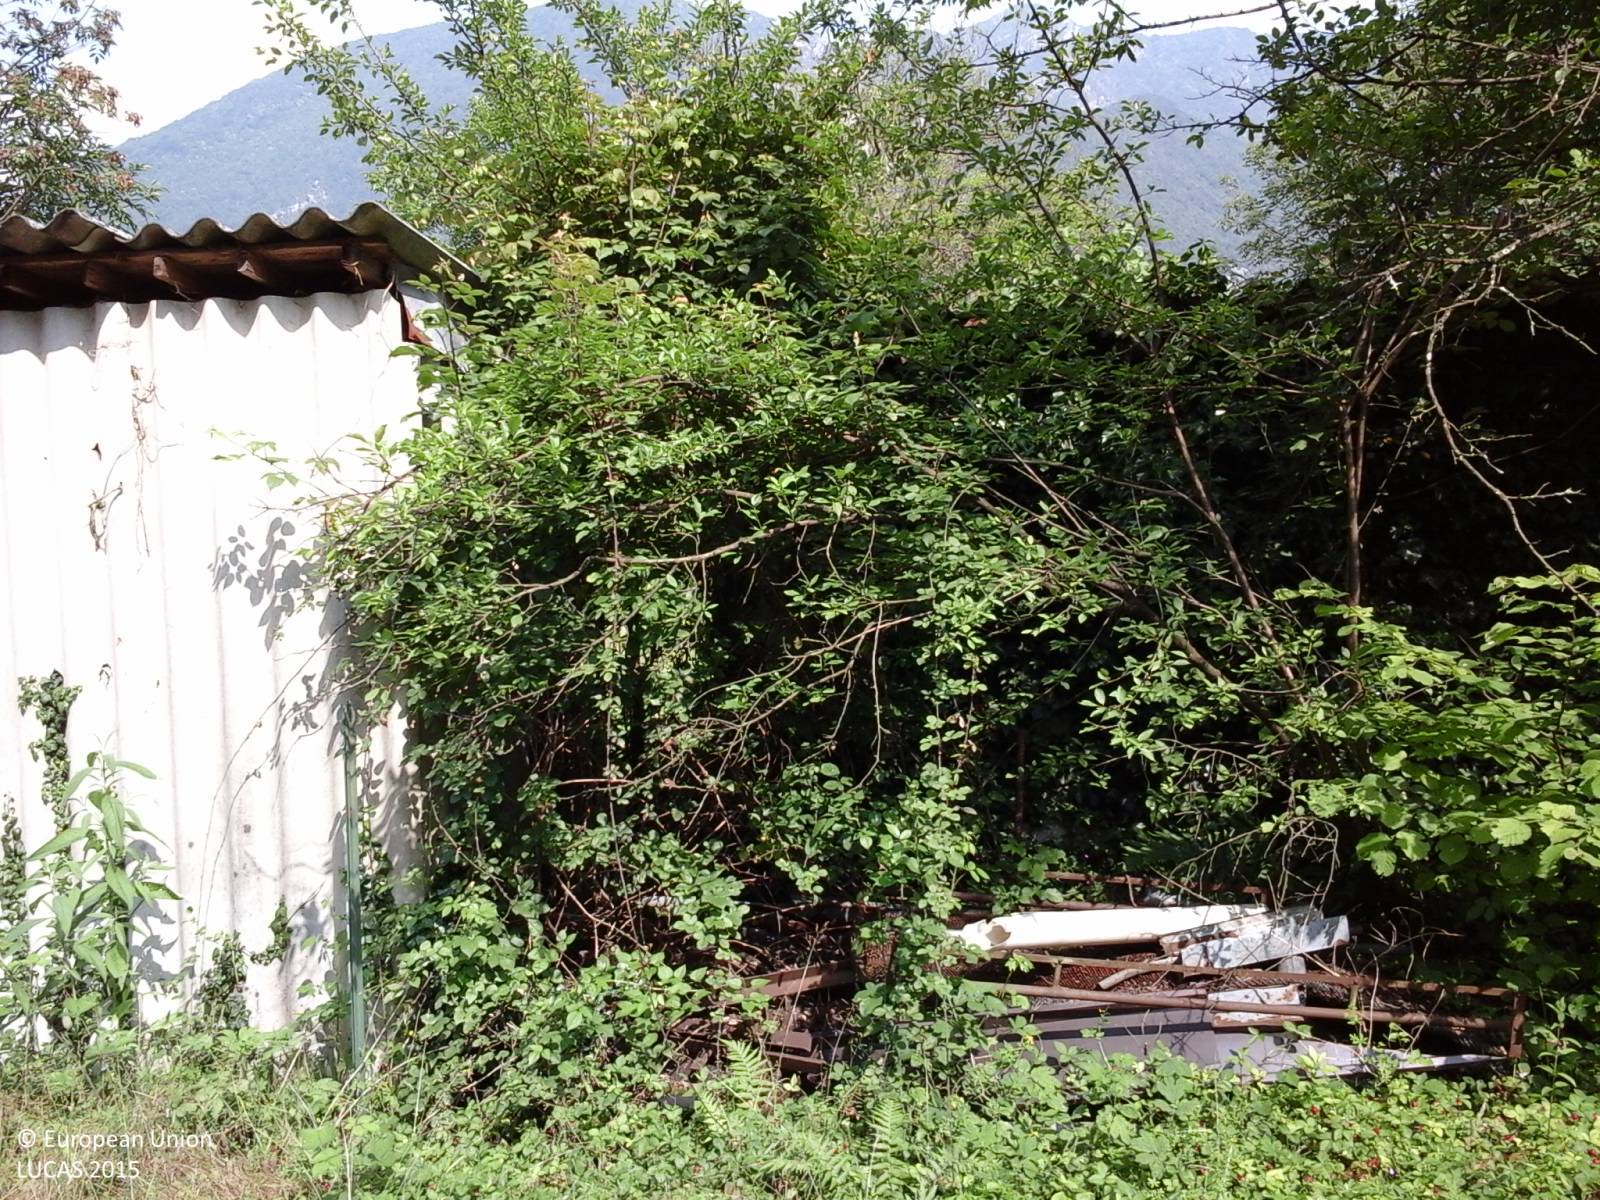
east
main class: Grassland
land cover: Grassland without tree/shrub cover
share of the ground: > 75 %
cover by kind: herbaceous plants 100 %
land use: Agriculture (excluding fallow land and kitchen gardens)
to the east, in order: Grassland without tree/shrub cover; Managed hedges; Artificial constructions in urban areas; Managed hedges; Grass margins; Potatoes; Grassland with sparse tree/shrub cover; Broadleaved woodland; Grassland without tree/shrub cover; Broadleaved woodland; Grassland without tree/shrub cover; Broadleaved woodland; Grassland without tree/shrub cover; Managed hedges; Artificial constructions; Paved roads, cycling and walking lanes; Artificial constructions; Managed hedges; Electric lines; Grassland with sparse tree/shrub cover; Managed hedges; Grassland without tree/shrub cover; Electric lines; Broadleaved woodland
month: June
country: IT
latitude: 46.3078
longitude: 13.0482
